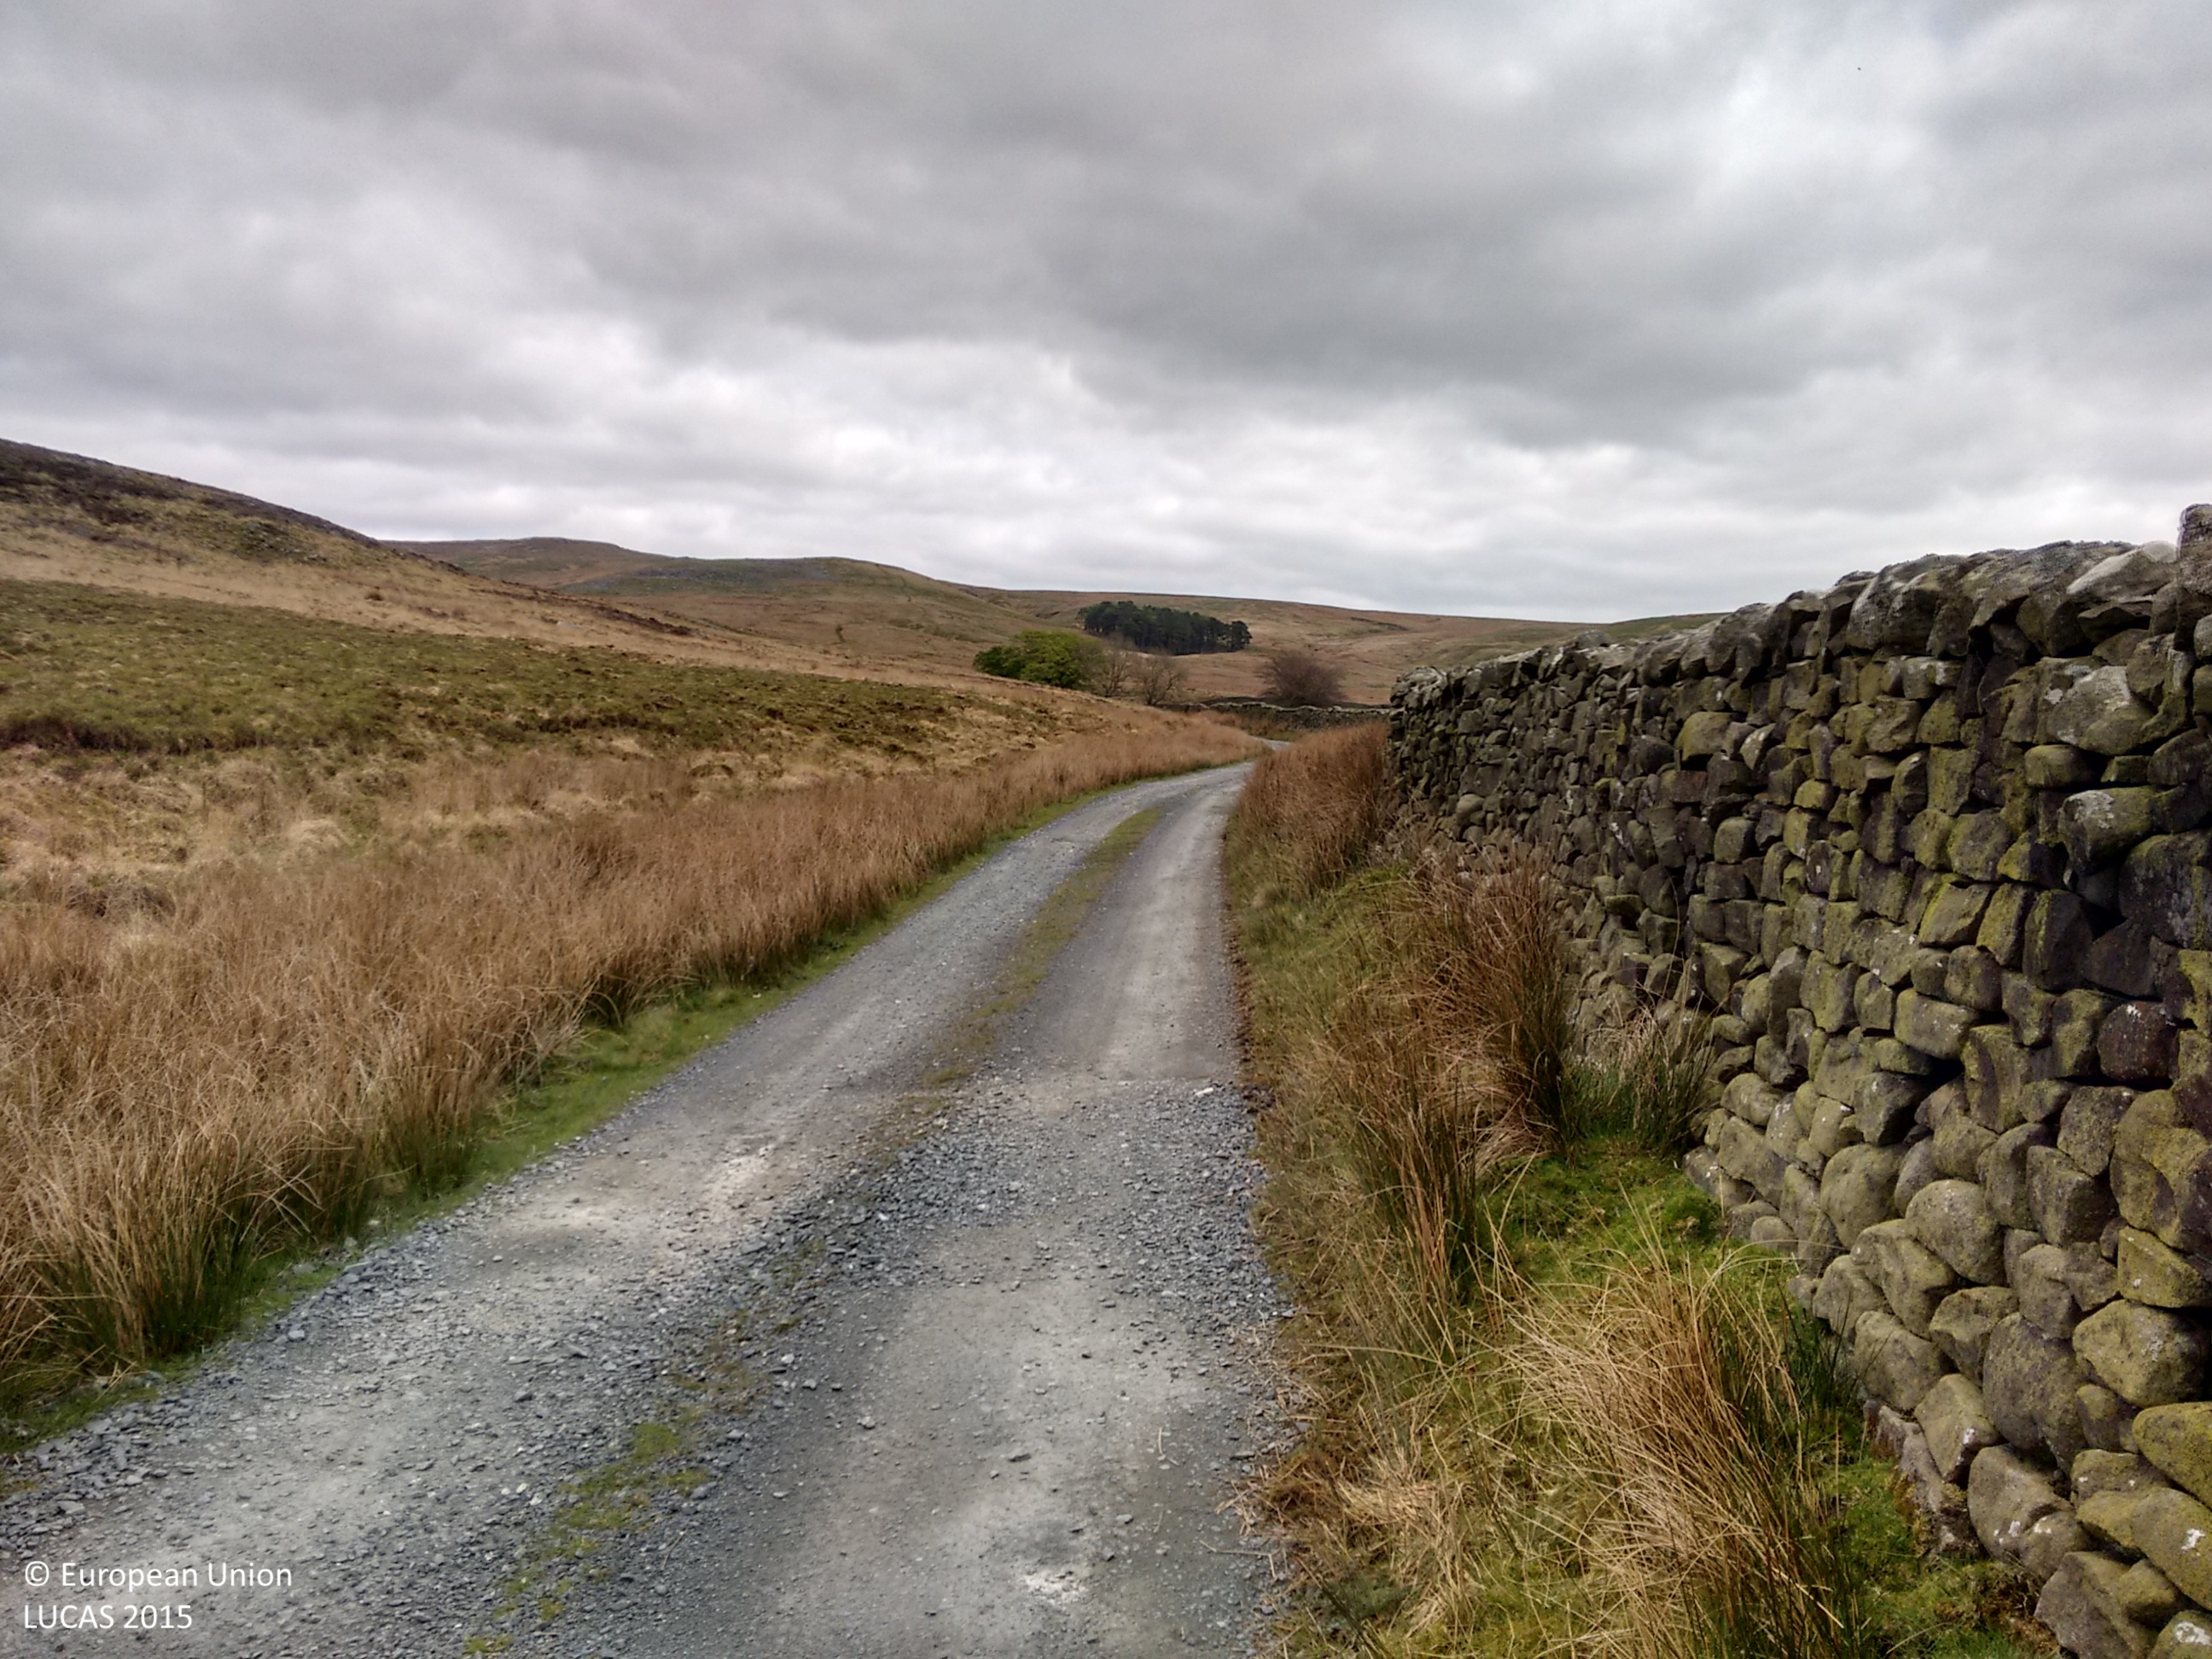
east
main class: Grassland
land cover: Grassland without tree/shrub cover
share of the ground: > 75 %
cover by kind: herbaceous plants 100 %
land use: Agriculture (excluding fallow land and kitchen gardens)
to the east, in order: Grassland without tree/shrub cover; Dry stone walls; Tracks; Grassland without tree/shrub cover
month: May
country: GB
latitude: 53.9948
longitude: -2.6206
